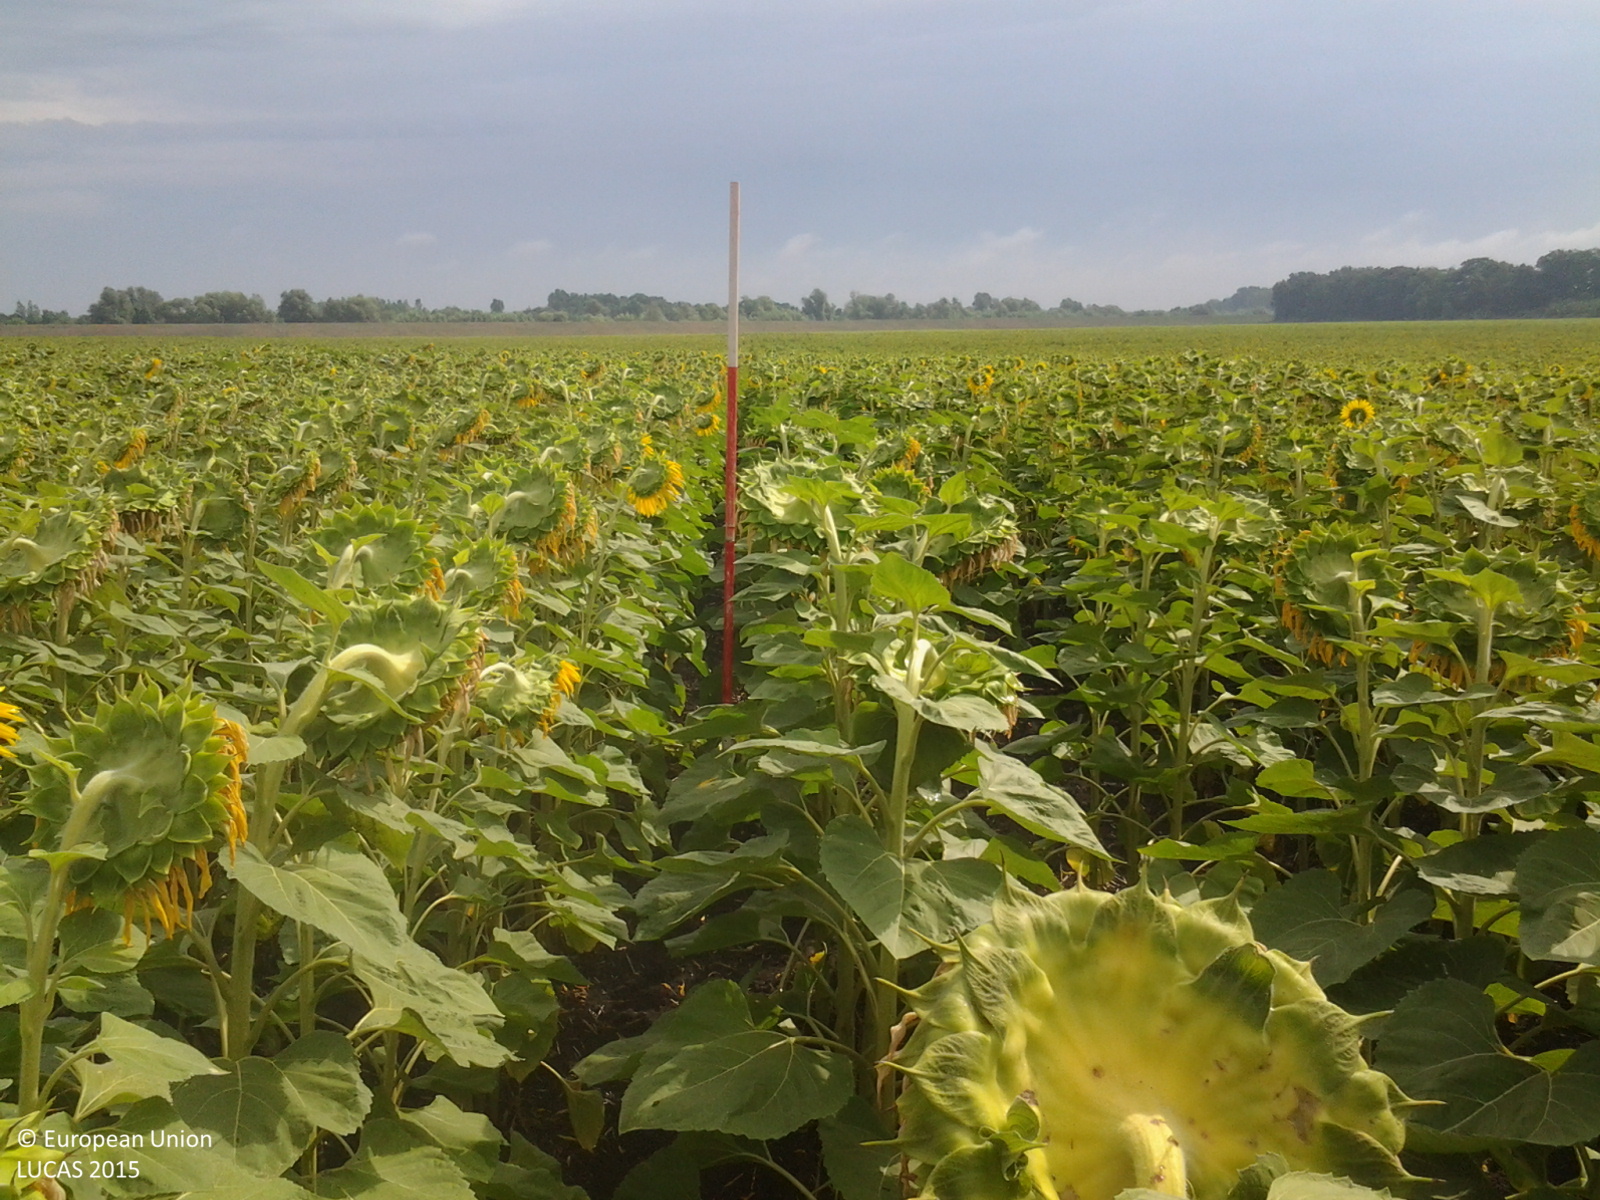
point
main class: Cropland
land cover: Sunflower
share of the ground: > 75 %
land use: Agriculture (excluding fallow land and kitchen gardens)
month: August
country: HU
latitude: 46.9762
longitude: 21.2235
